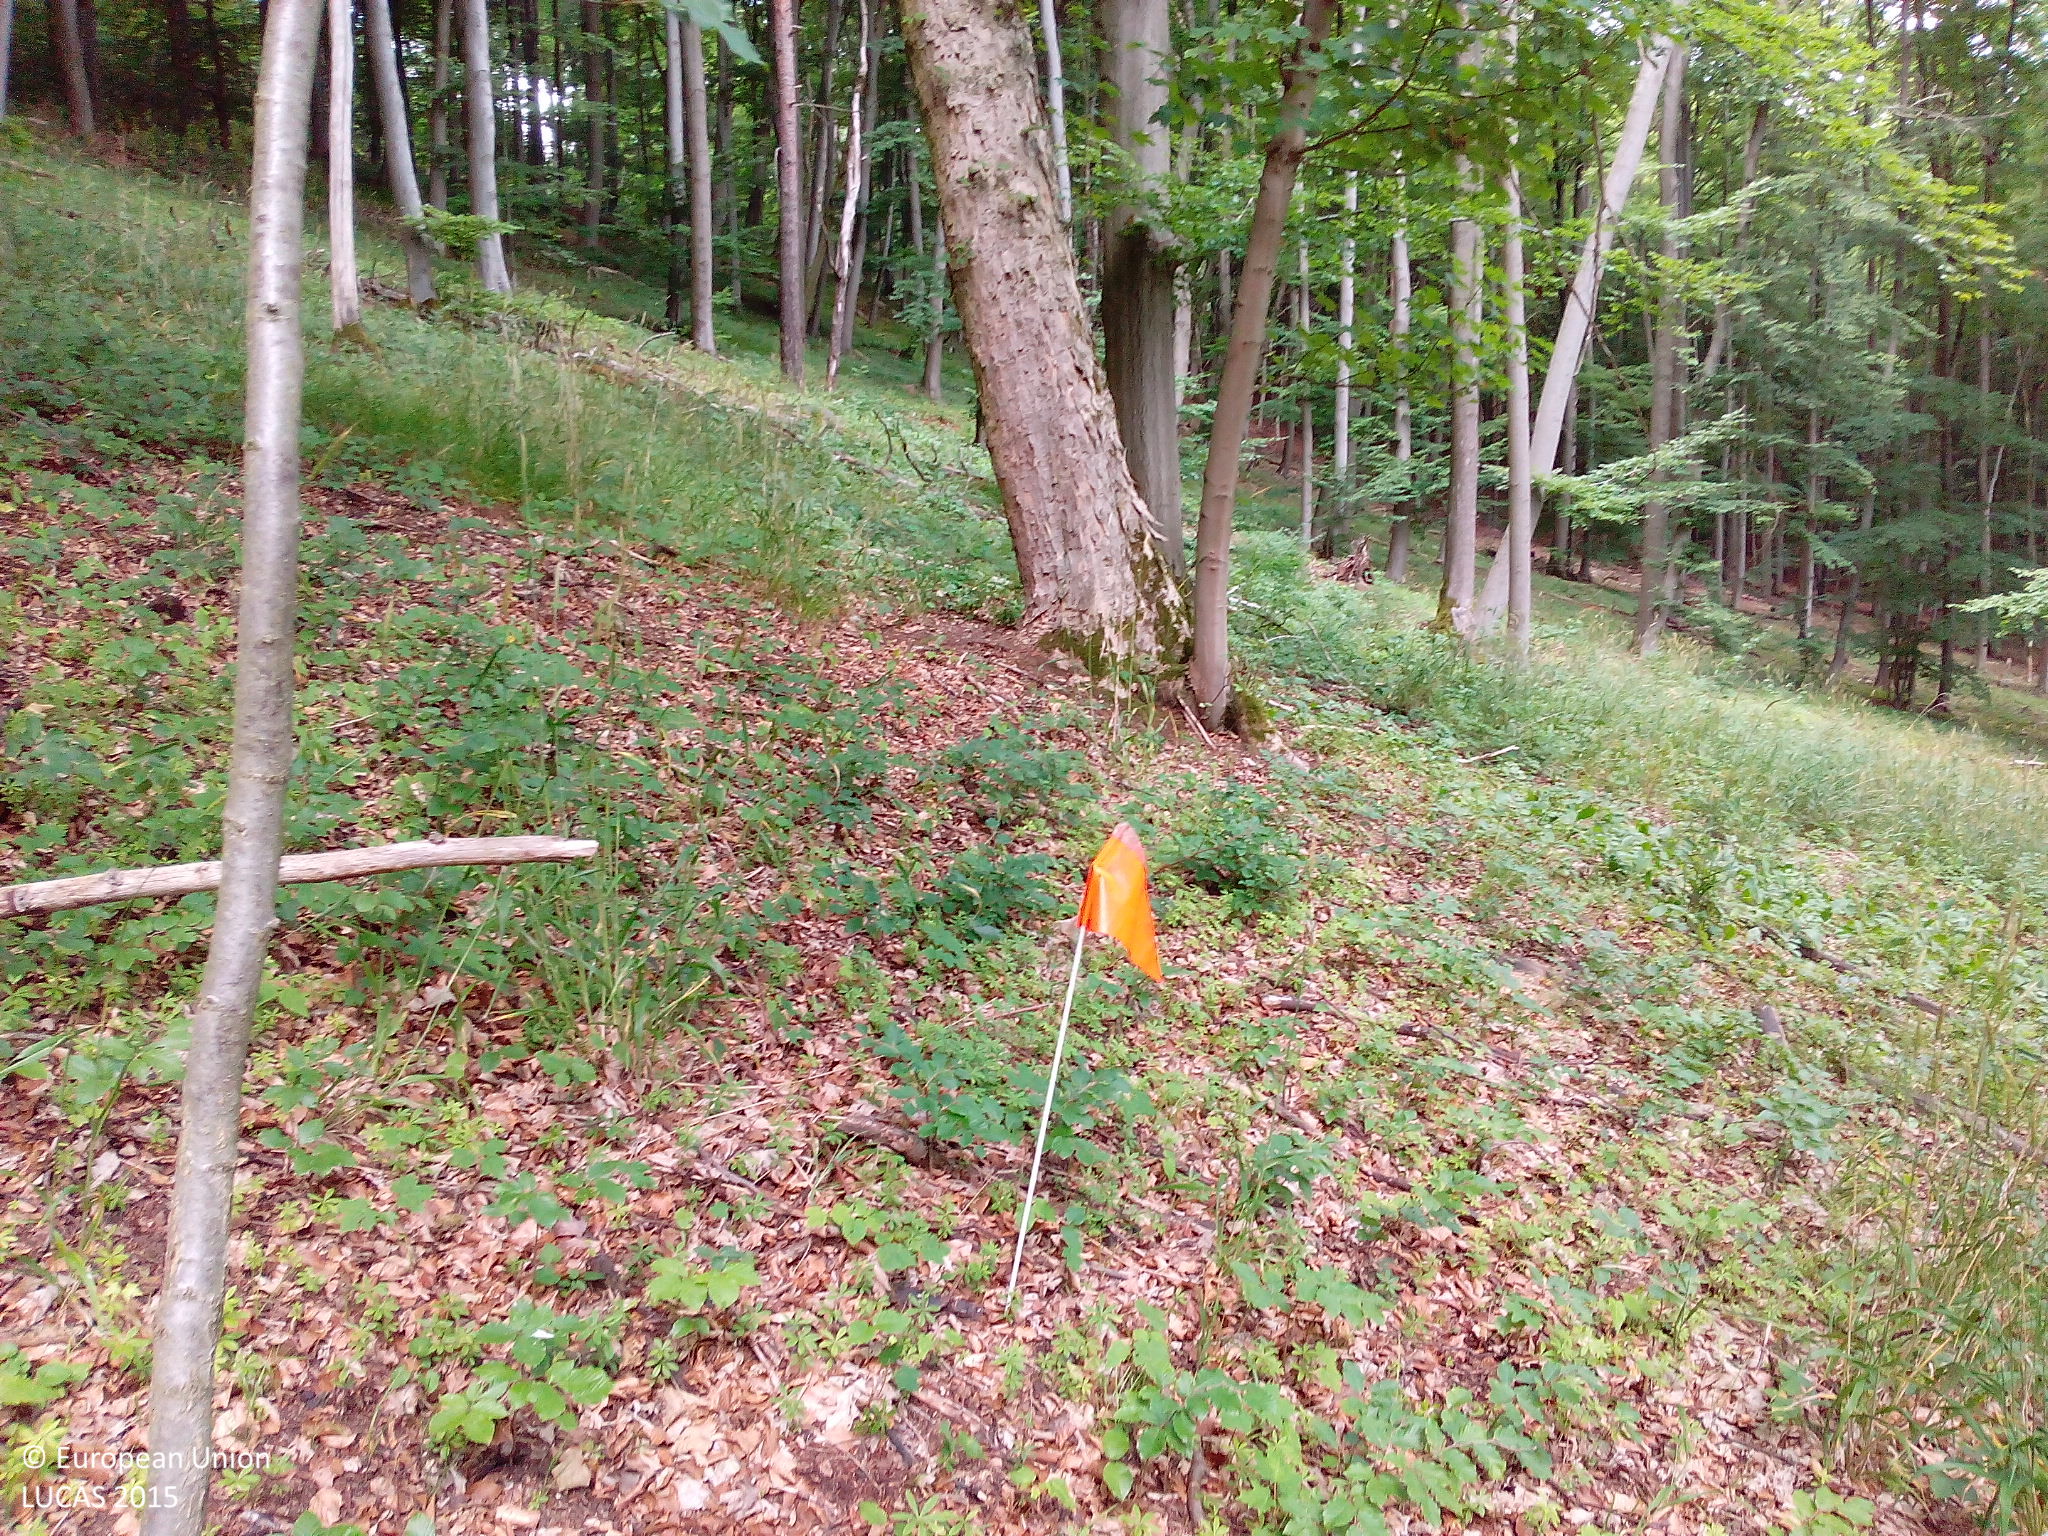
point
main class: Woodland
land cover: Broadleaved woodland
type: beech forest
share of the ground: > 75 %
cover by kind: broadleaved forest trees 90 %, herbaceous plants 5 %, unconsolidated bare surface 5 %
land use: Forestry
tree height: > 5 m
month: July
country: DE
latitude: 50.7416
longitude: 9.9008
